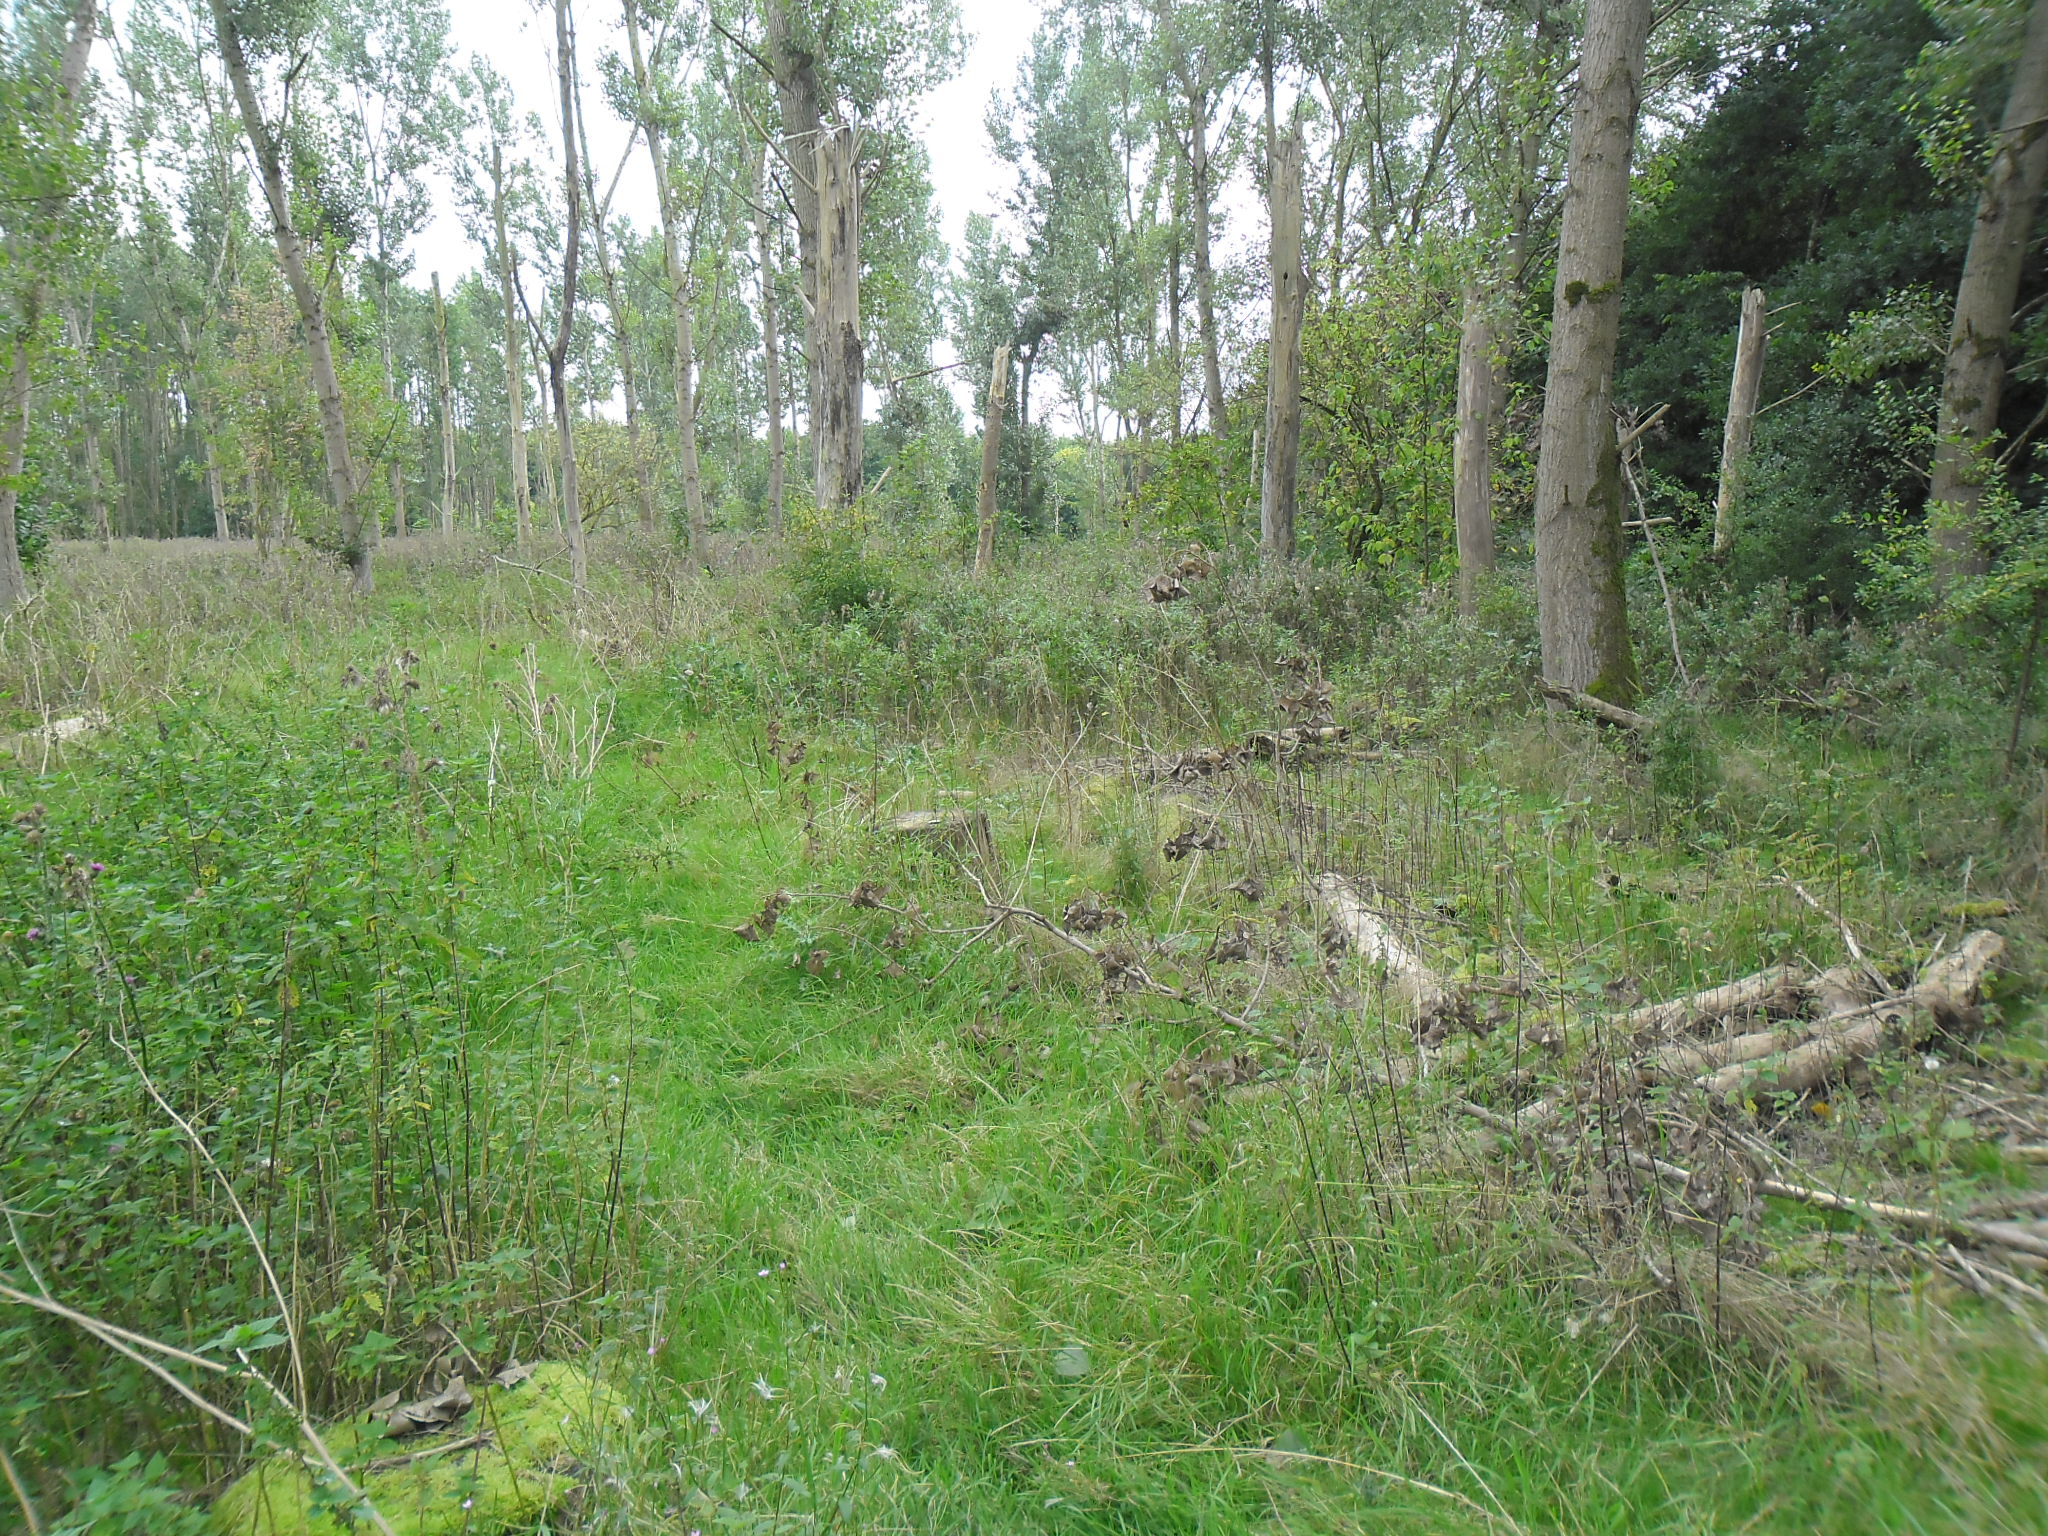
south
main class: Woodland
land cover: Broadleaved woodland
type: non-riverine alder, birch or aspen forest
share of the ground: > 75 %
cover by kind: broadleaved forest trees 80 %, herbaceous plants 20 %
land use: Forestry
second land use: Amenities, museums, leisure
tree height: > 5 m
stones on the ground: < 10 %
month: September
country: NL
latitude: 52.2910
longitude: 5.4680
